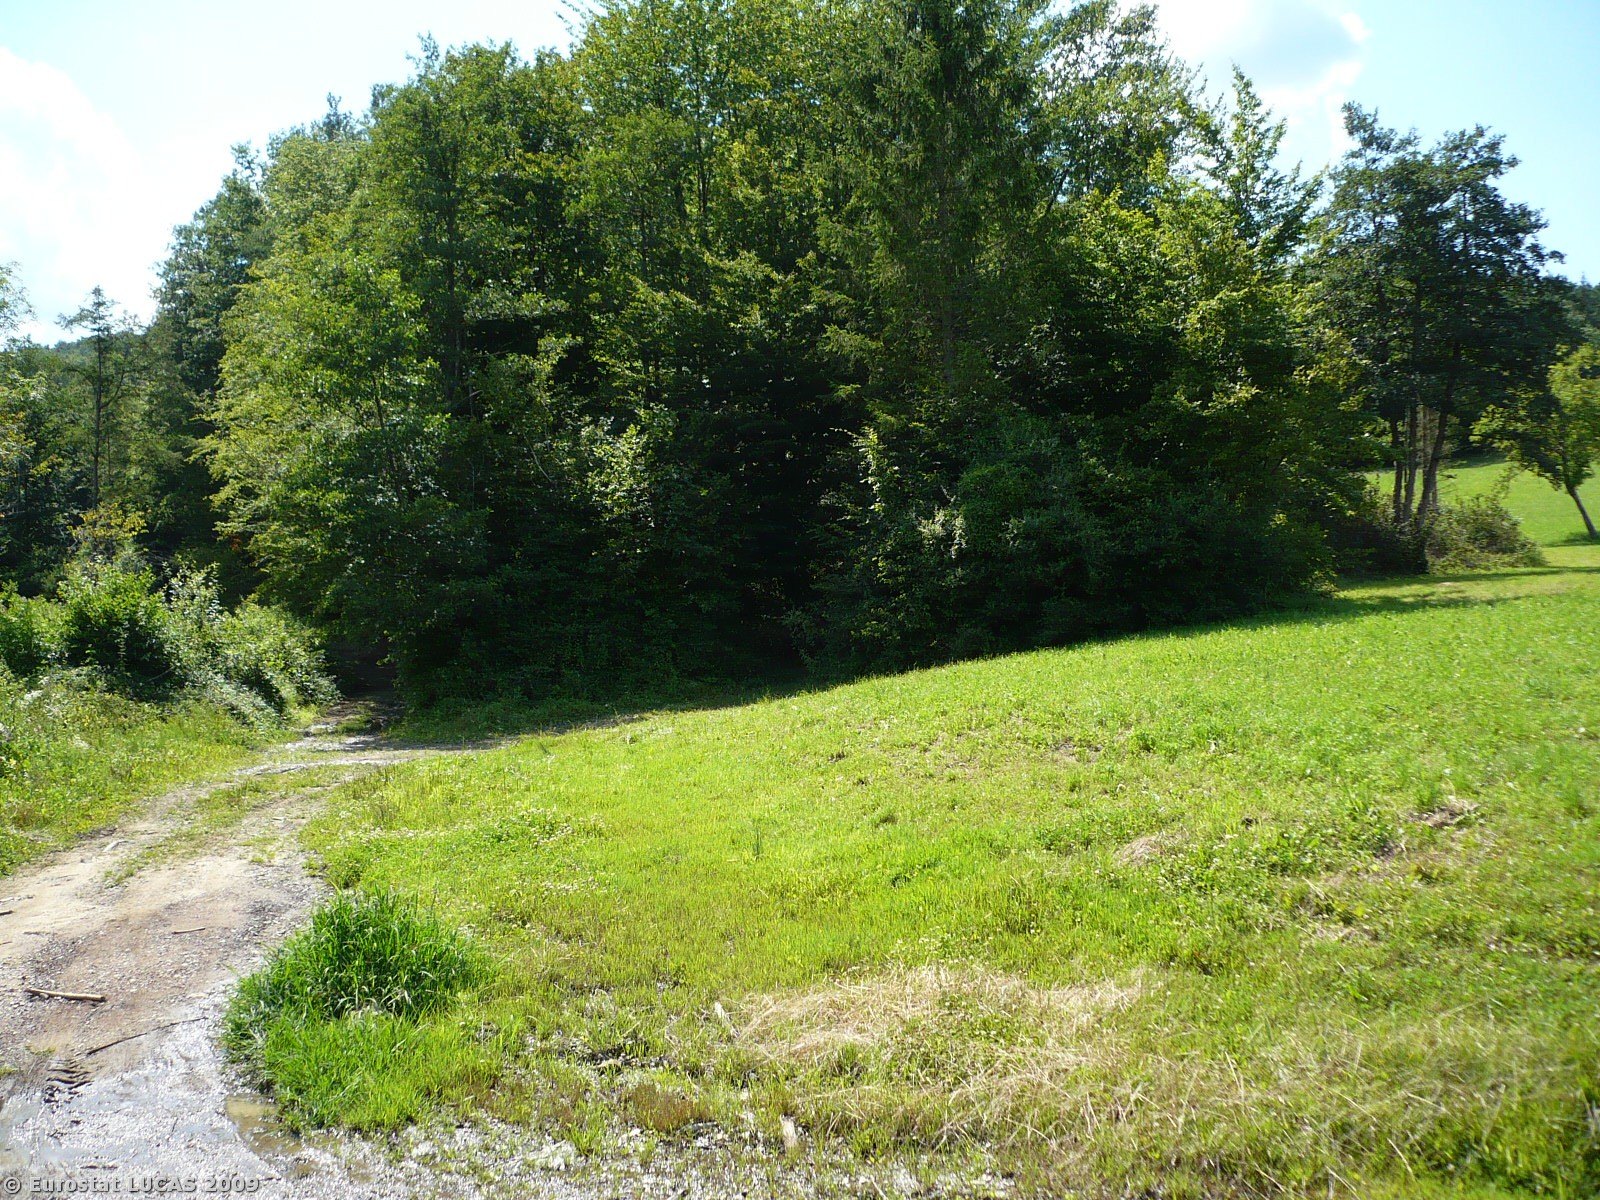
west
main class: Grassland
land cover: Grassland without tree/shrub cover
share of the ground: > 75 %
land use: Agriculture (excluding fallow land and kitchen gardens)
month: July
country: SI
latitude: 45.5838
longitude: 14.1865
